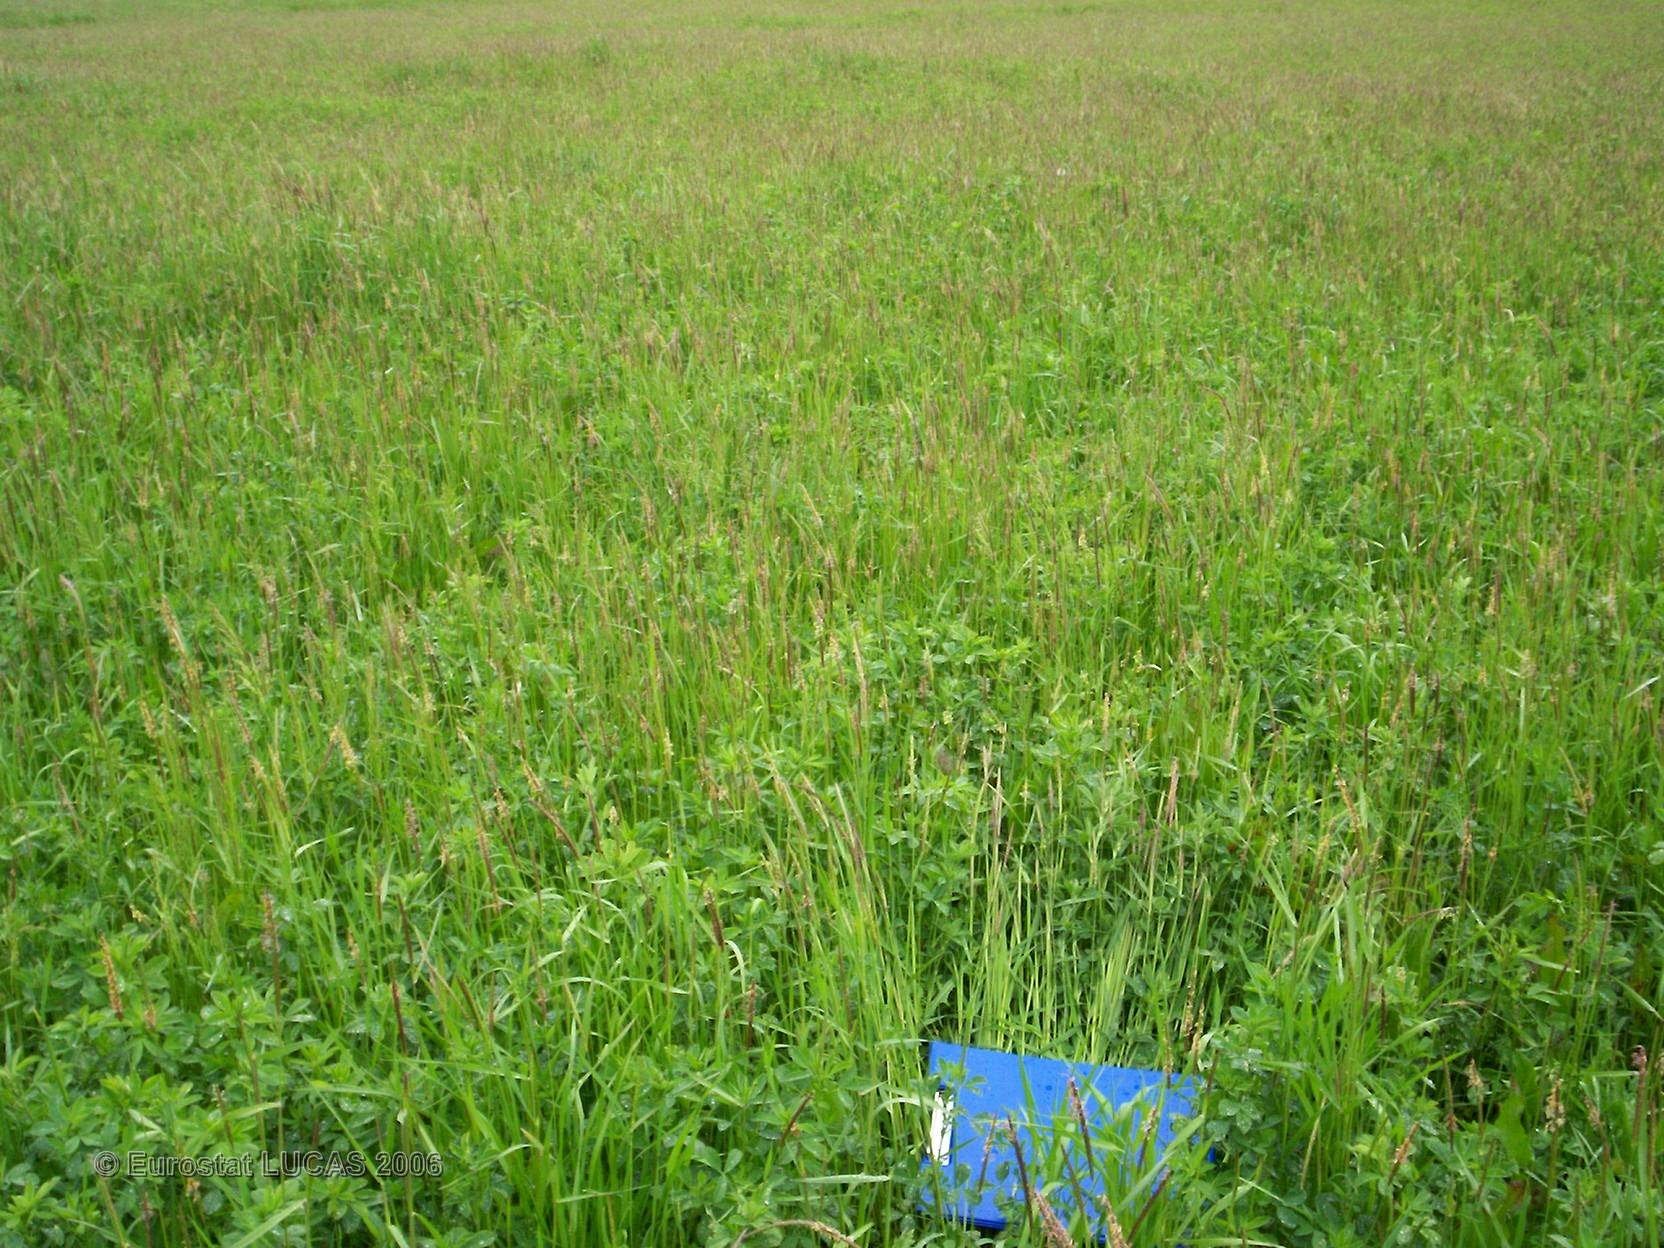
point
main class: Cropland
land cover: Other leguminous and mixtures for fodder
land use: Agriculture (excluding fallow land and kitchen gardens)
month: April
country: FR
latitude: 43.7114
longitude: 0.2776
